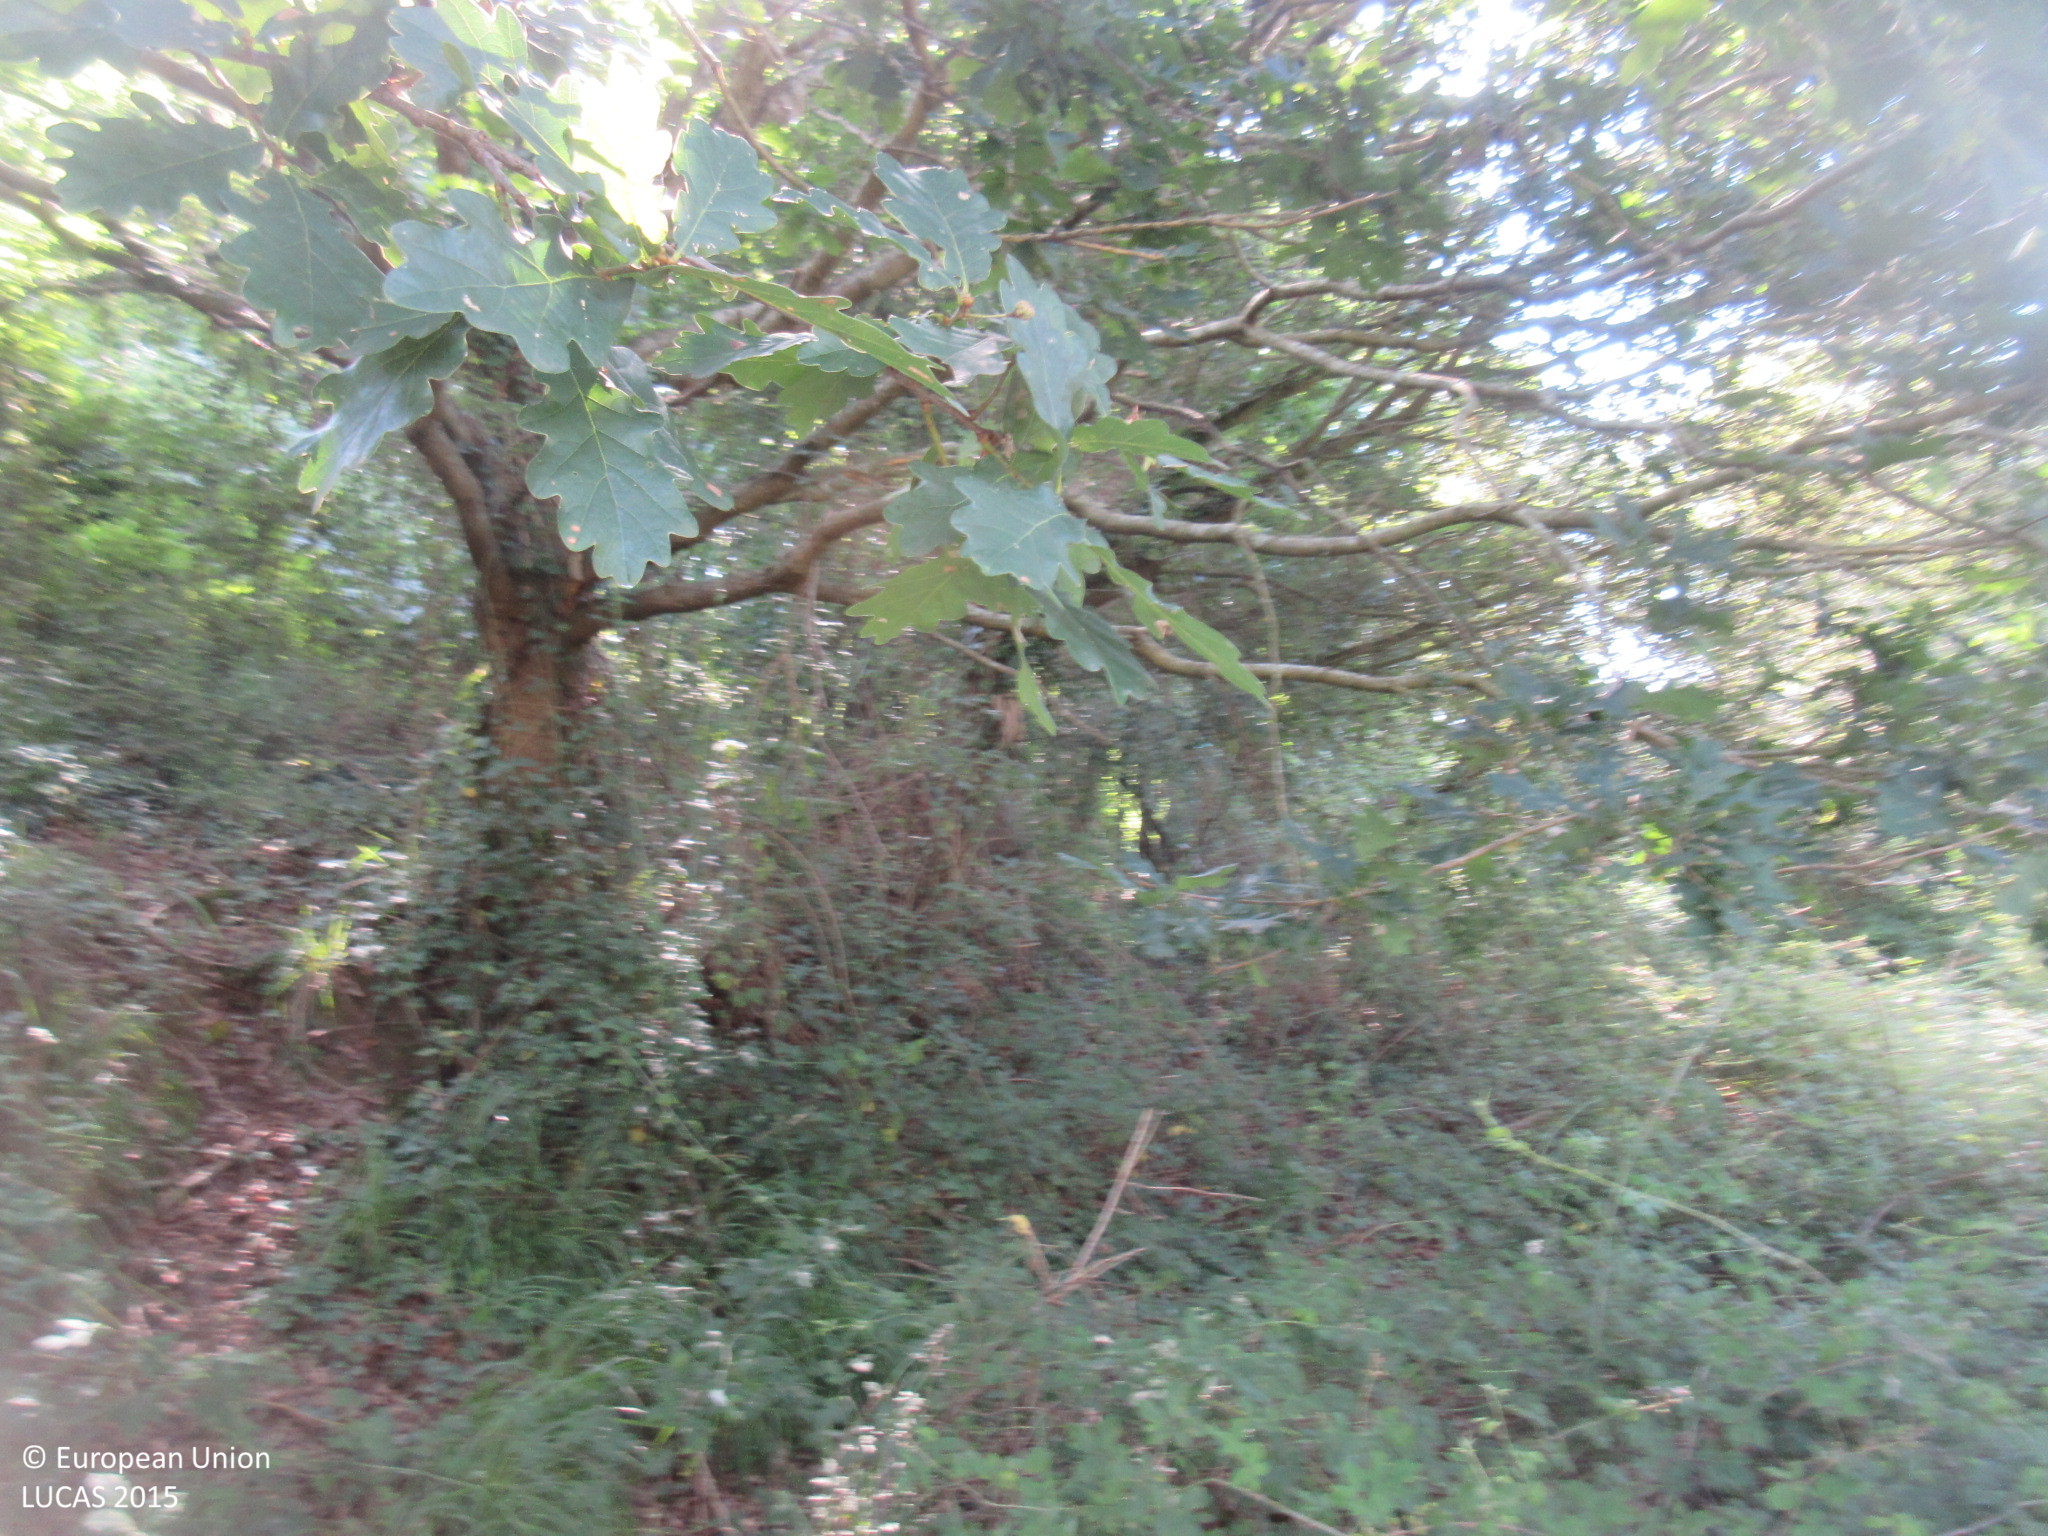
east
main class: Woodland
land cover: Broadleaved woodland
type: exotic forest
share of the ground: > 75 %
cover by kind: broadleaved forest trees 90 %, shrubs 10 %
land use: Forestry
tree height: > 5 m
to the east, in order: Broadleaved woodland; Grassland without tree/shrub cover
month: July
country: ES
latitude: 43.4040
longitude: -3.9423
